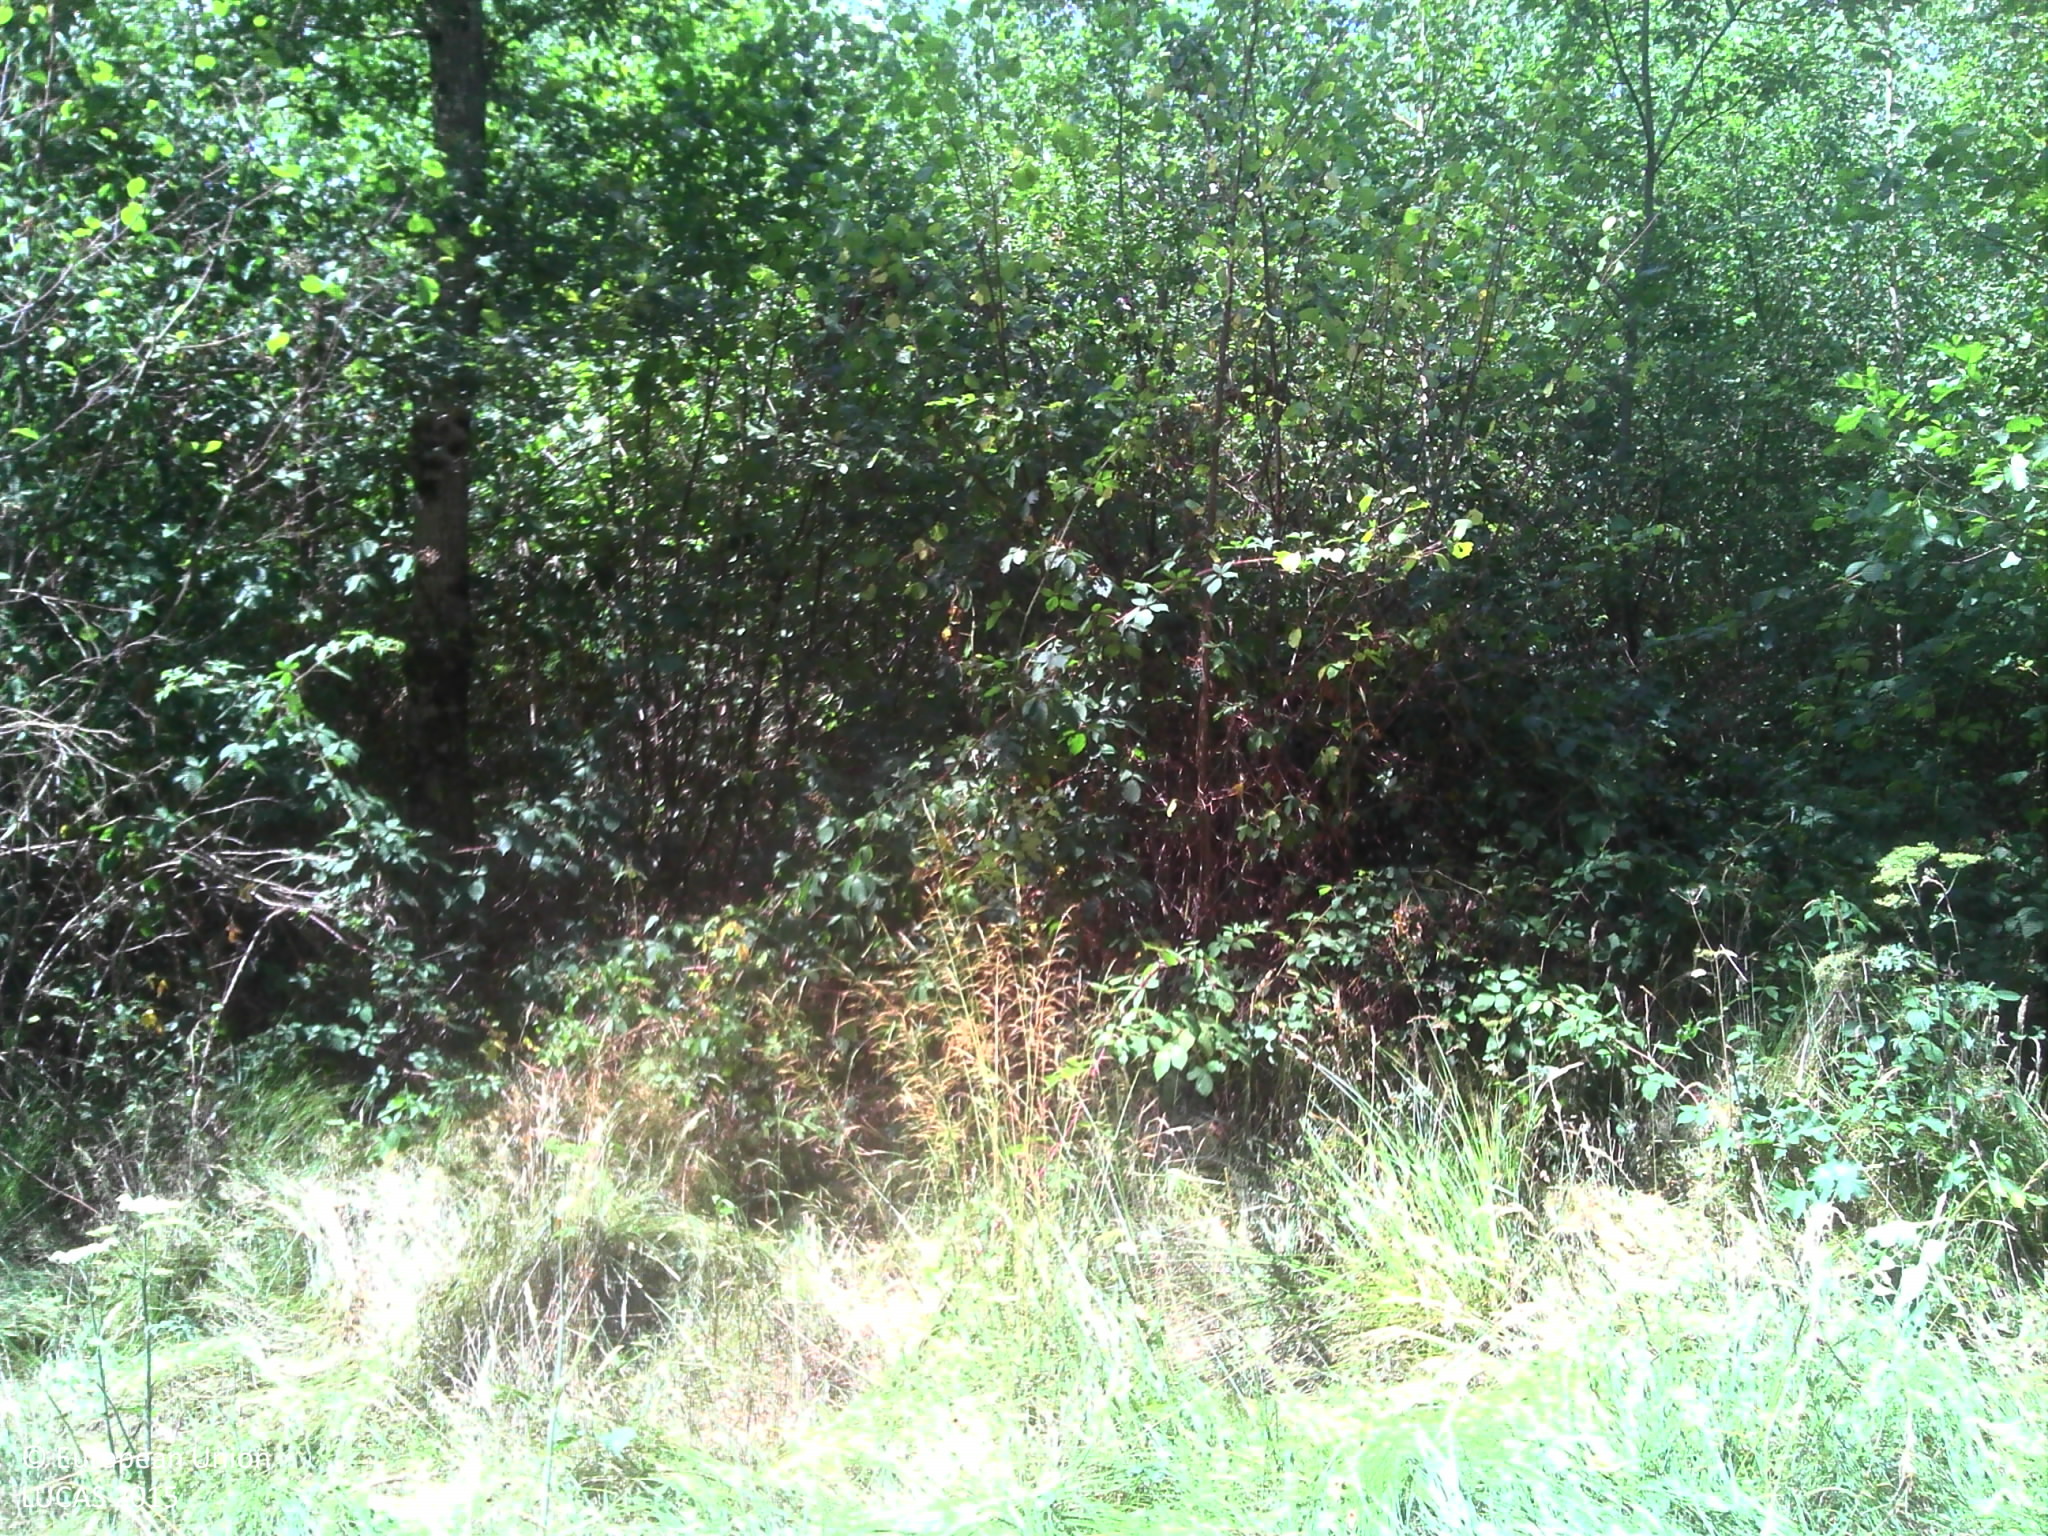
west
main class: Woodland
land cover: Broadleaved woodland
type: non-riverine alder, birch or aspen forest
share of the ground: > 75 %
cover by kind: broadleaved forest trees 80 %, herbaceous plants 20 %
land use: Forestry
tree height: > 5 m
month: July
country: FR
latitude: 46.8121
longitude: 5.0083
